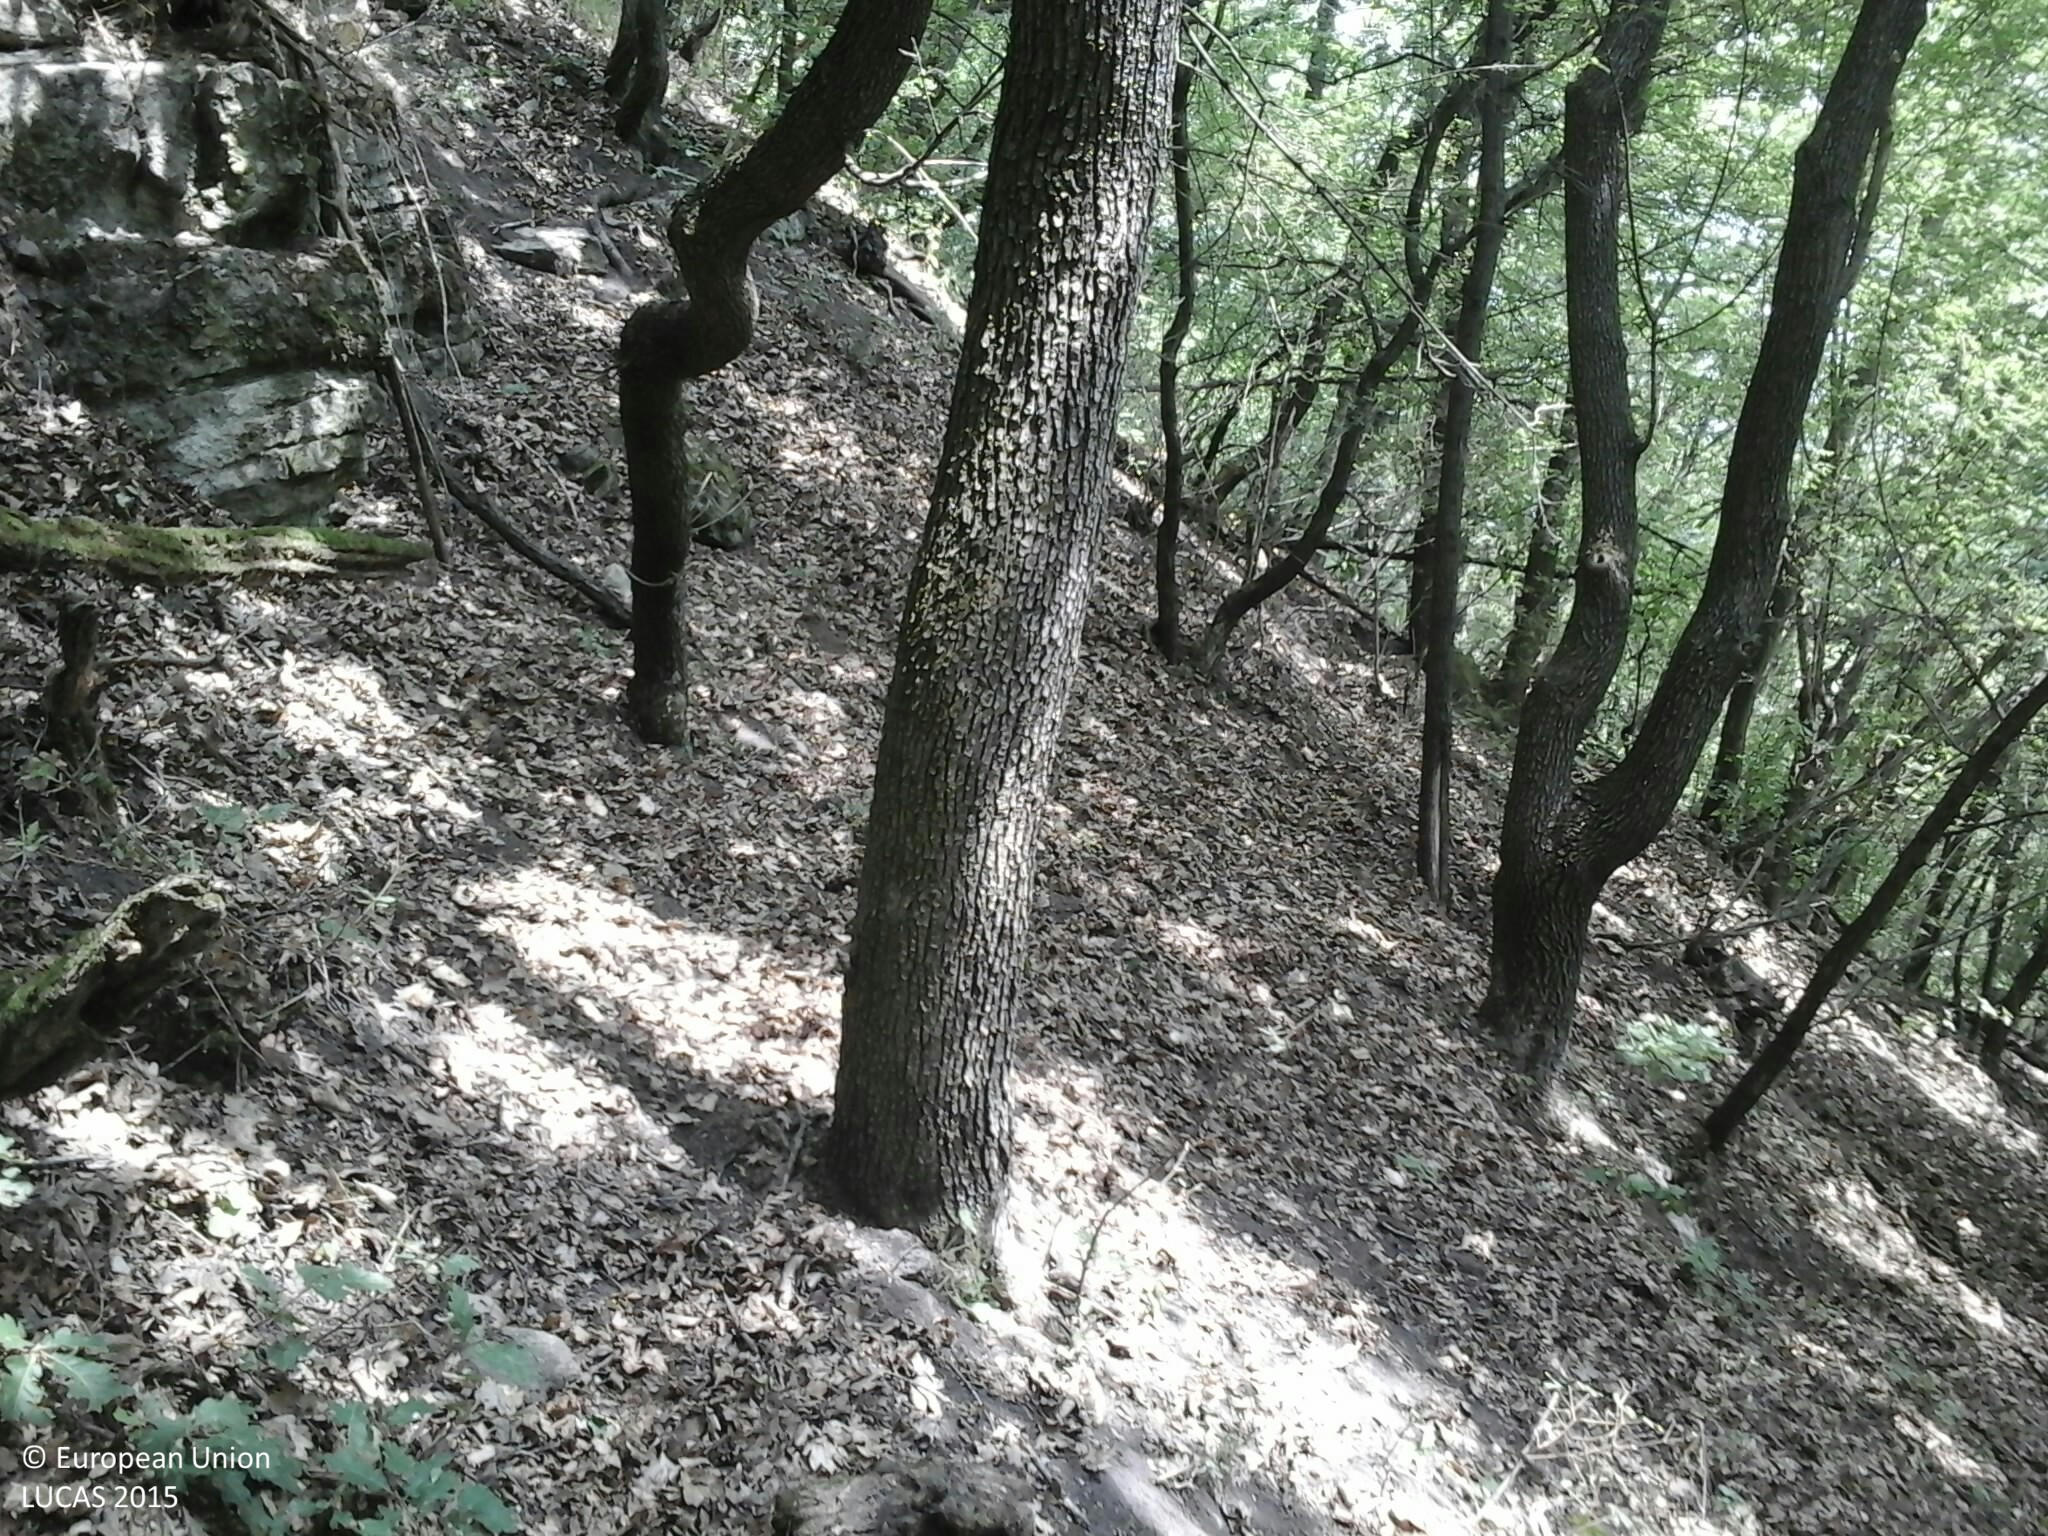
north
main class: Woodland
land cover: Broadleaved woodland
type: mesophytic deciduous forest
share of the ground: > 75 %
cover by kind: broadleaved forest trees 95 %, unconsolidated bare surface 5 %
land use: Forestry
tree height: > 5 m
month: June
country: HU
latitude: 47.7043
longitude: 19.0676
